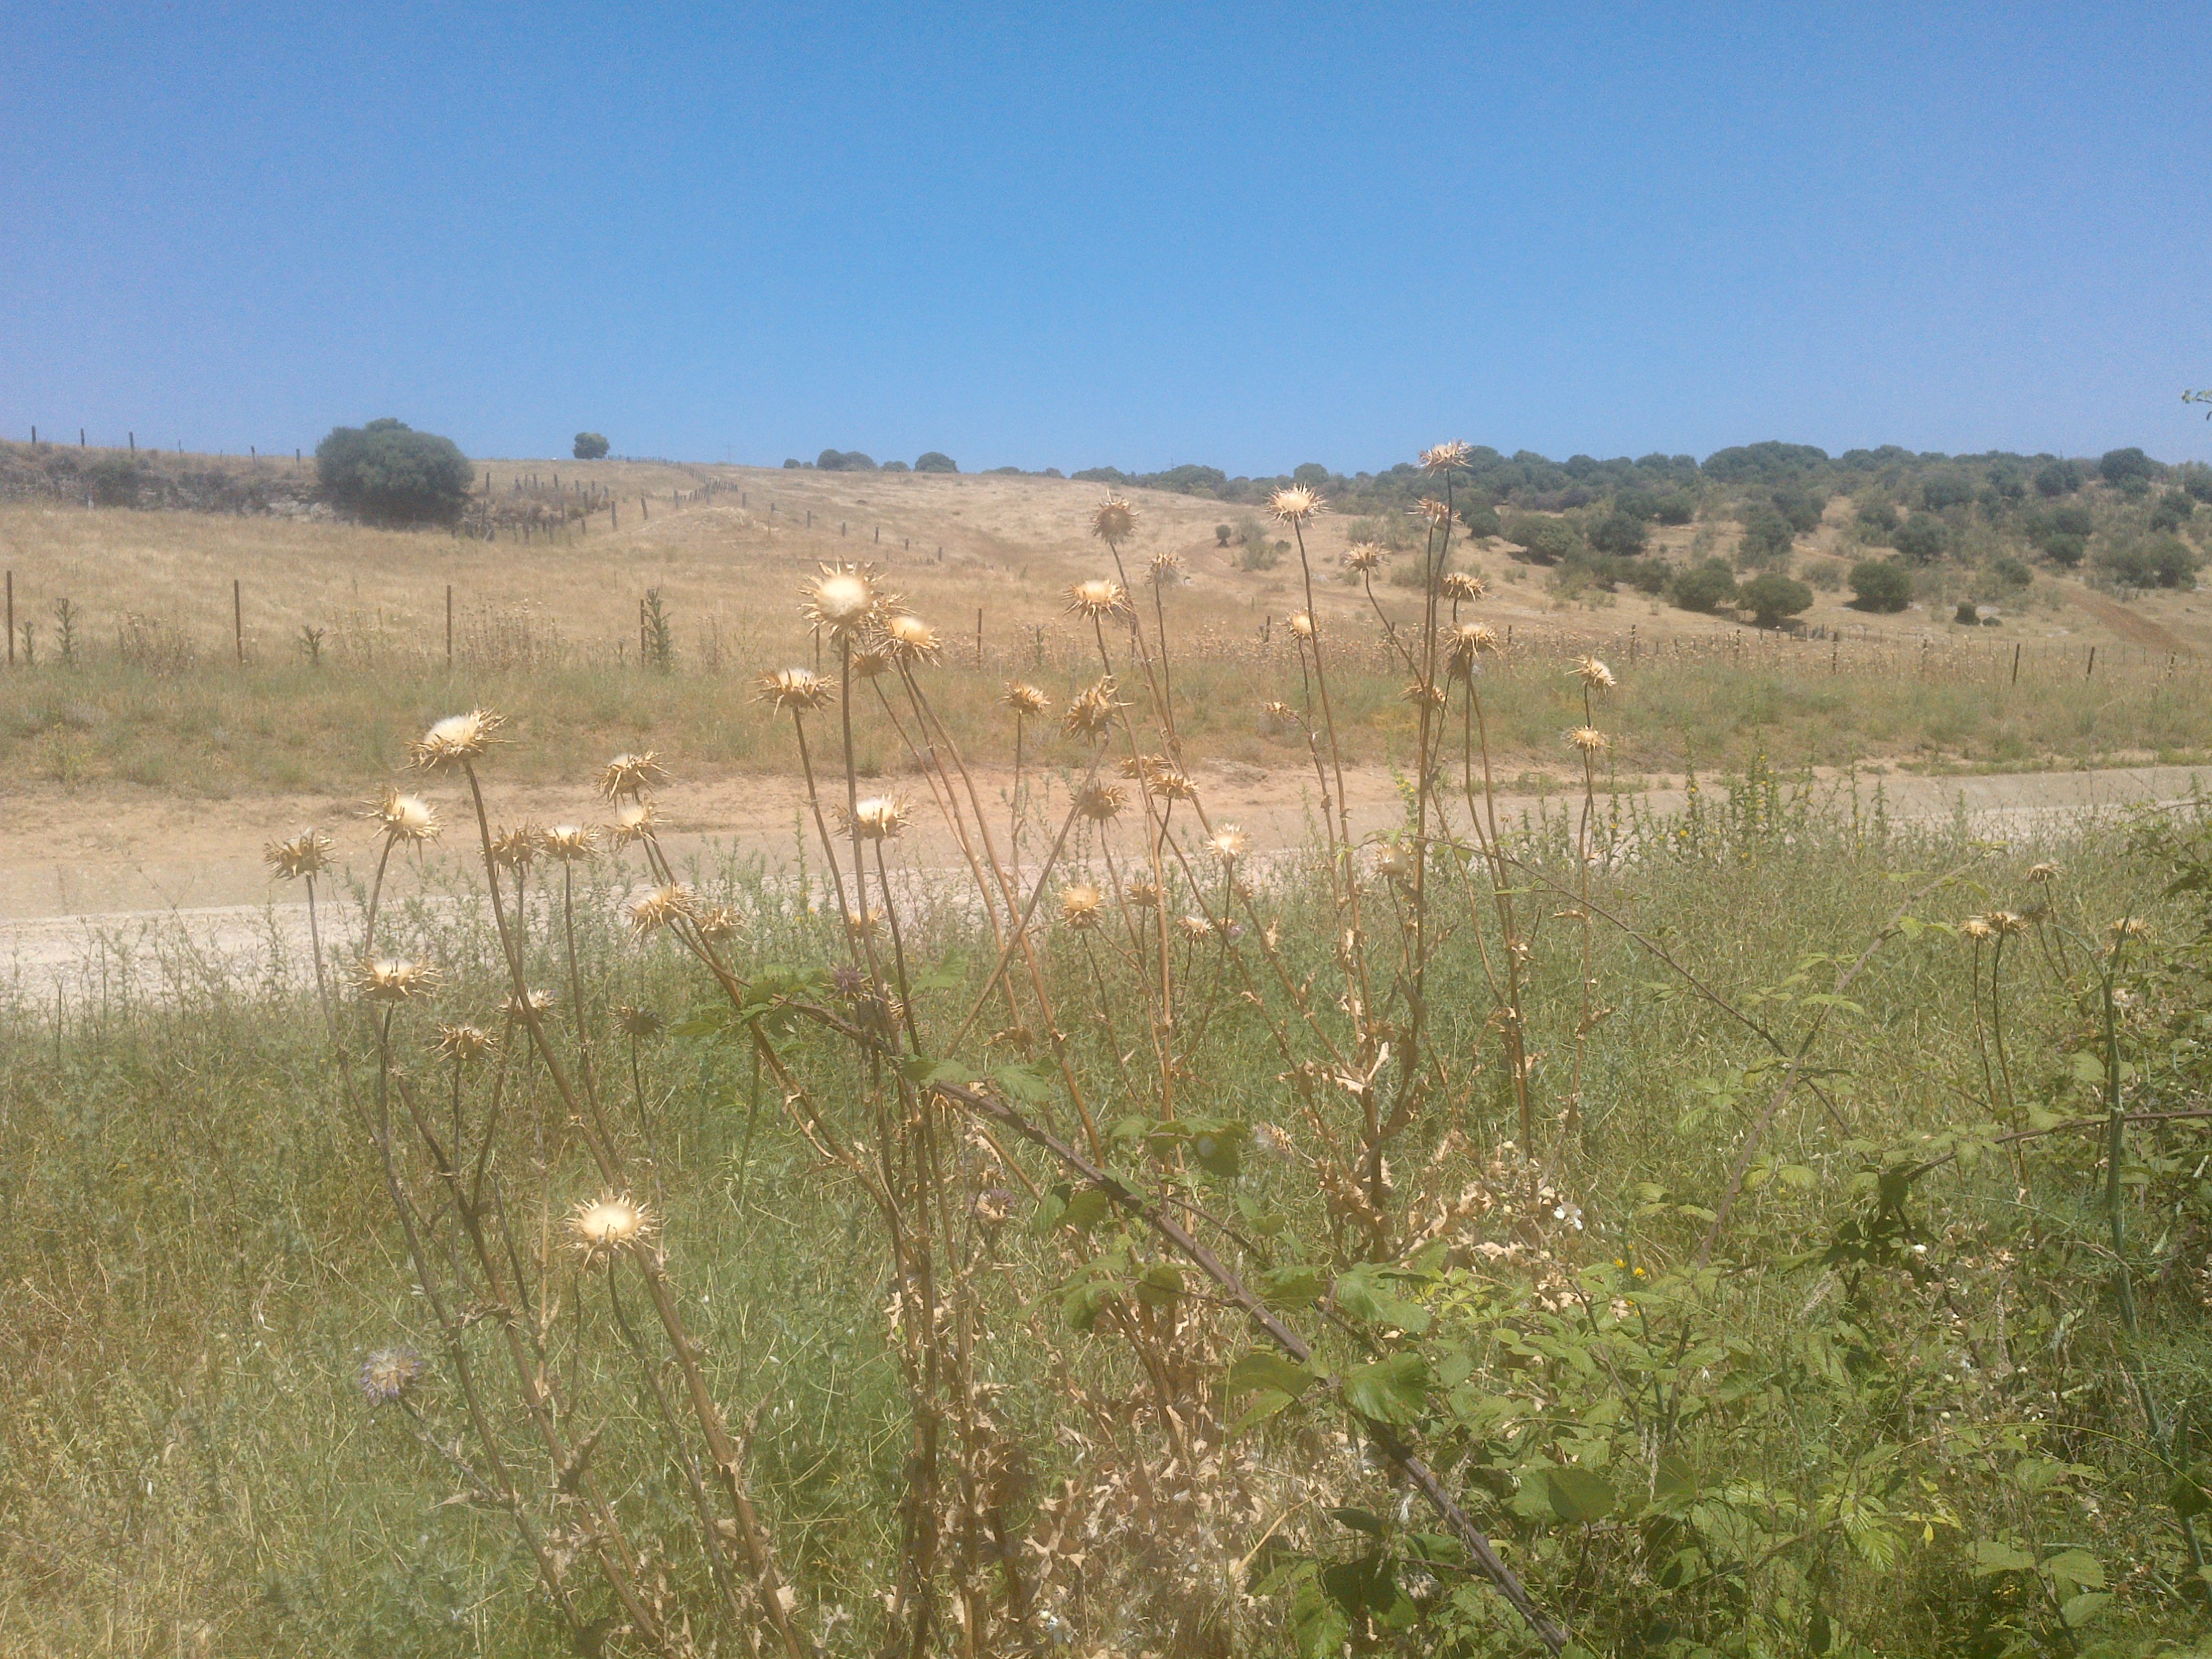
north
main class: Cropland
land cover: Maize
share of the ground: > 75 %
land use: Agriculture (excluding fallow land and kitchen gardens)
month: May
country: ES
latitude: 37.8697
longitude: -4.9193
